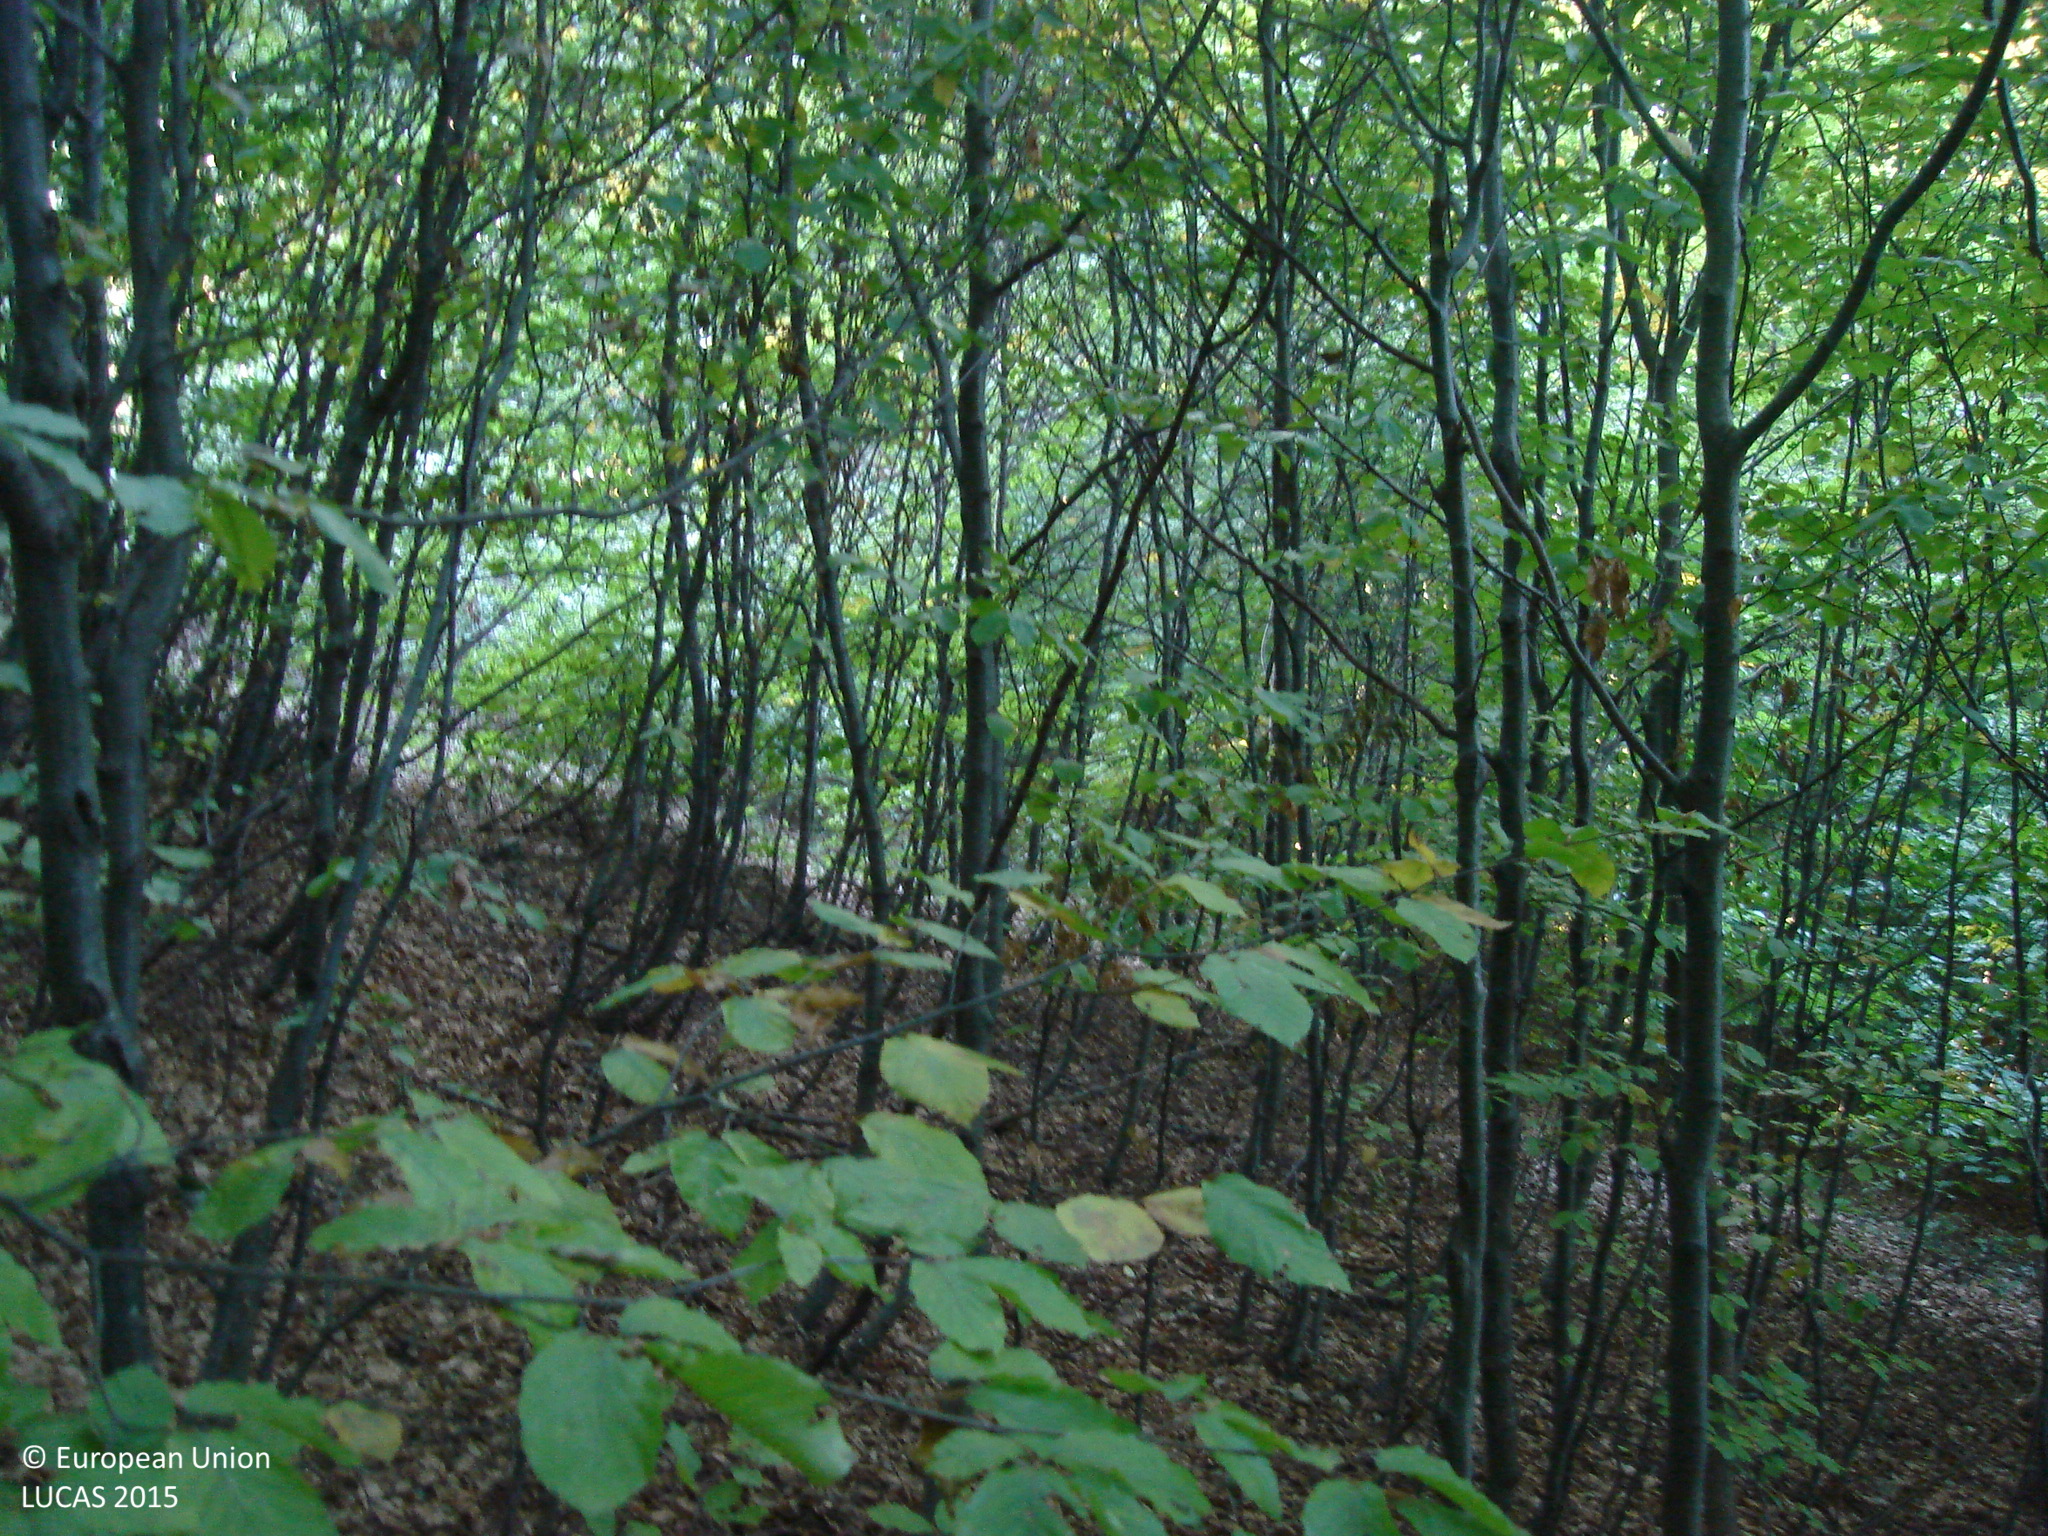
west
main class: Woodland
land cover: Broadleaved woodland
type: beech forest
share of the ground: > 75 %
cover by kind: broadleaved forest trees 85 %, consolidated bare surface 10 %, lichens and mosses 5 %
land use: Forestry
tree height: > 5 m
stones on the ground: < 10 %
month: October
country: BG
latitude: 43.1442
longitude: 23.4300
